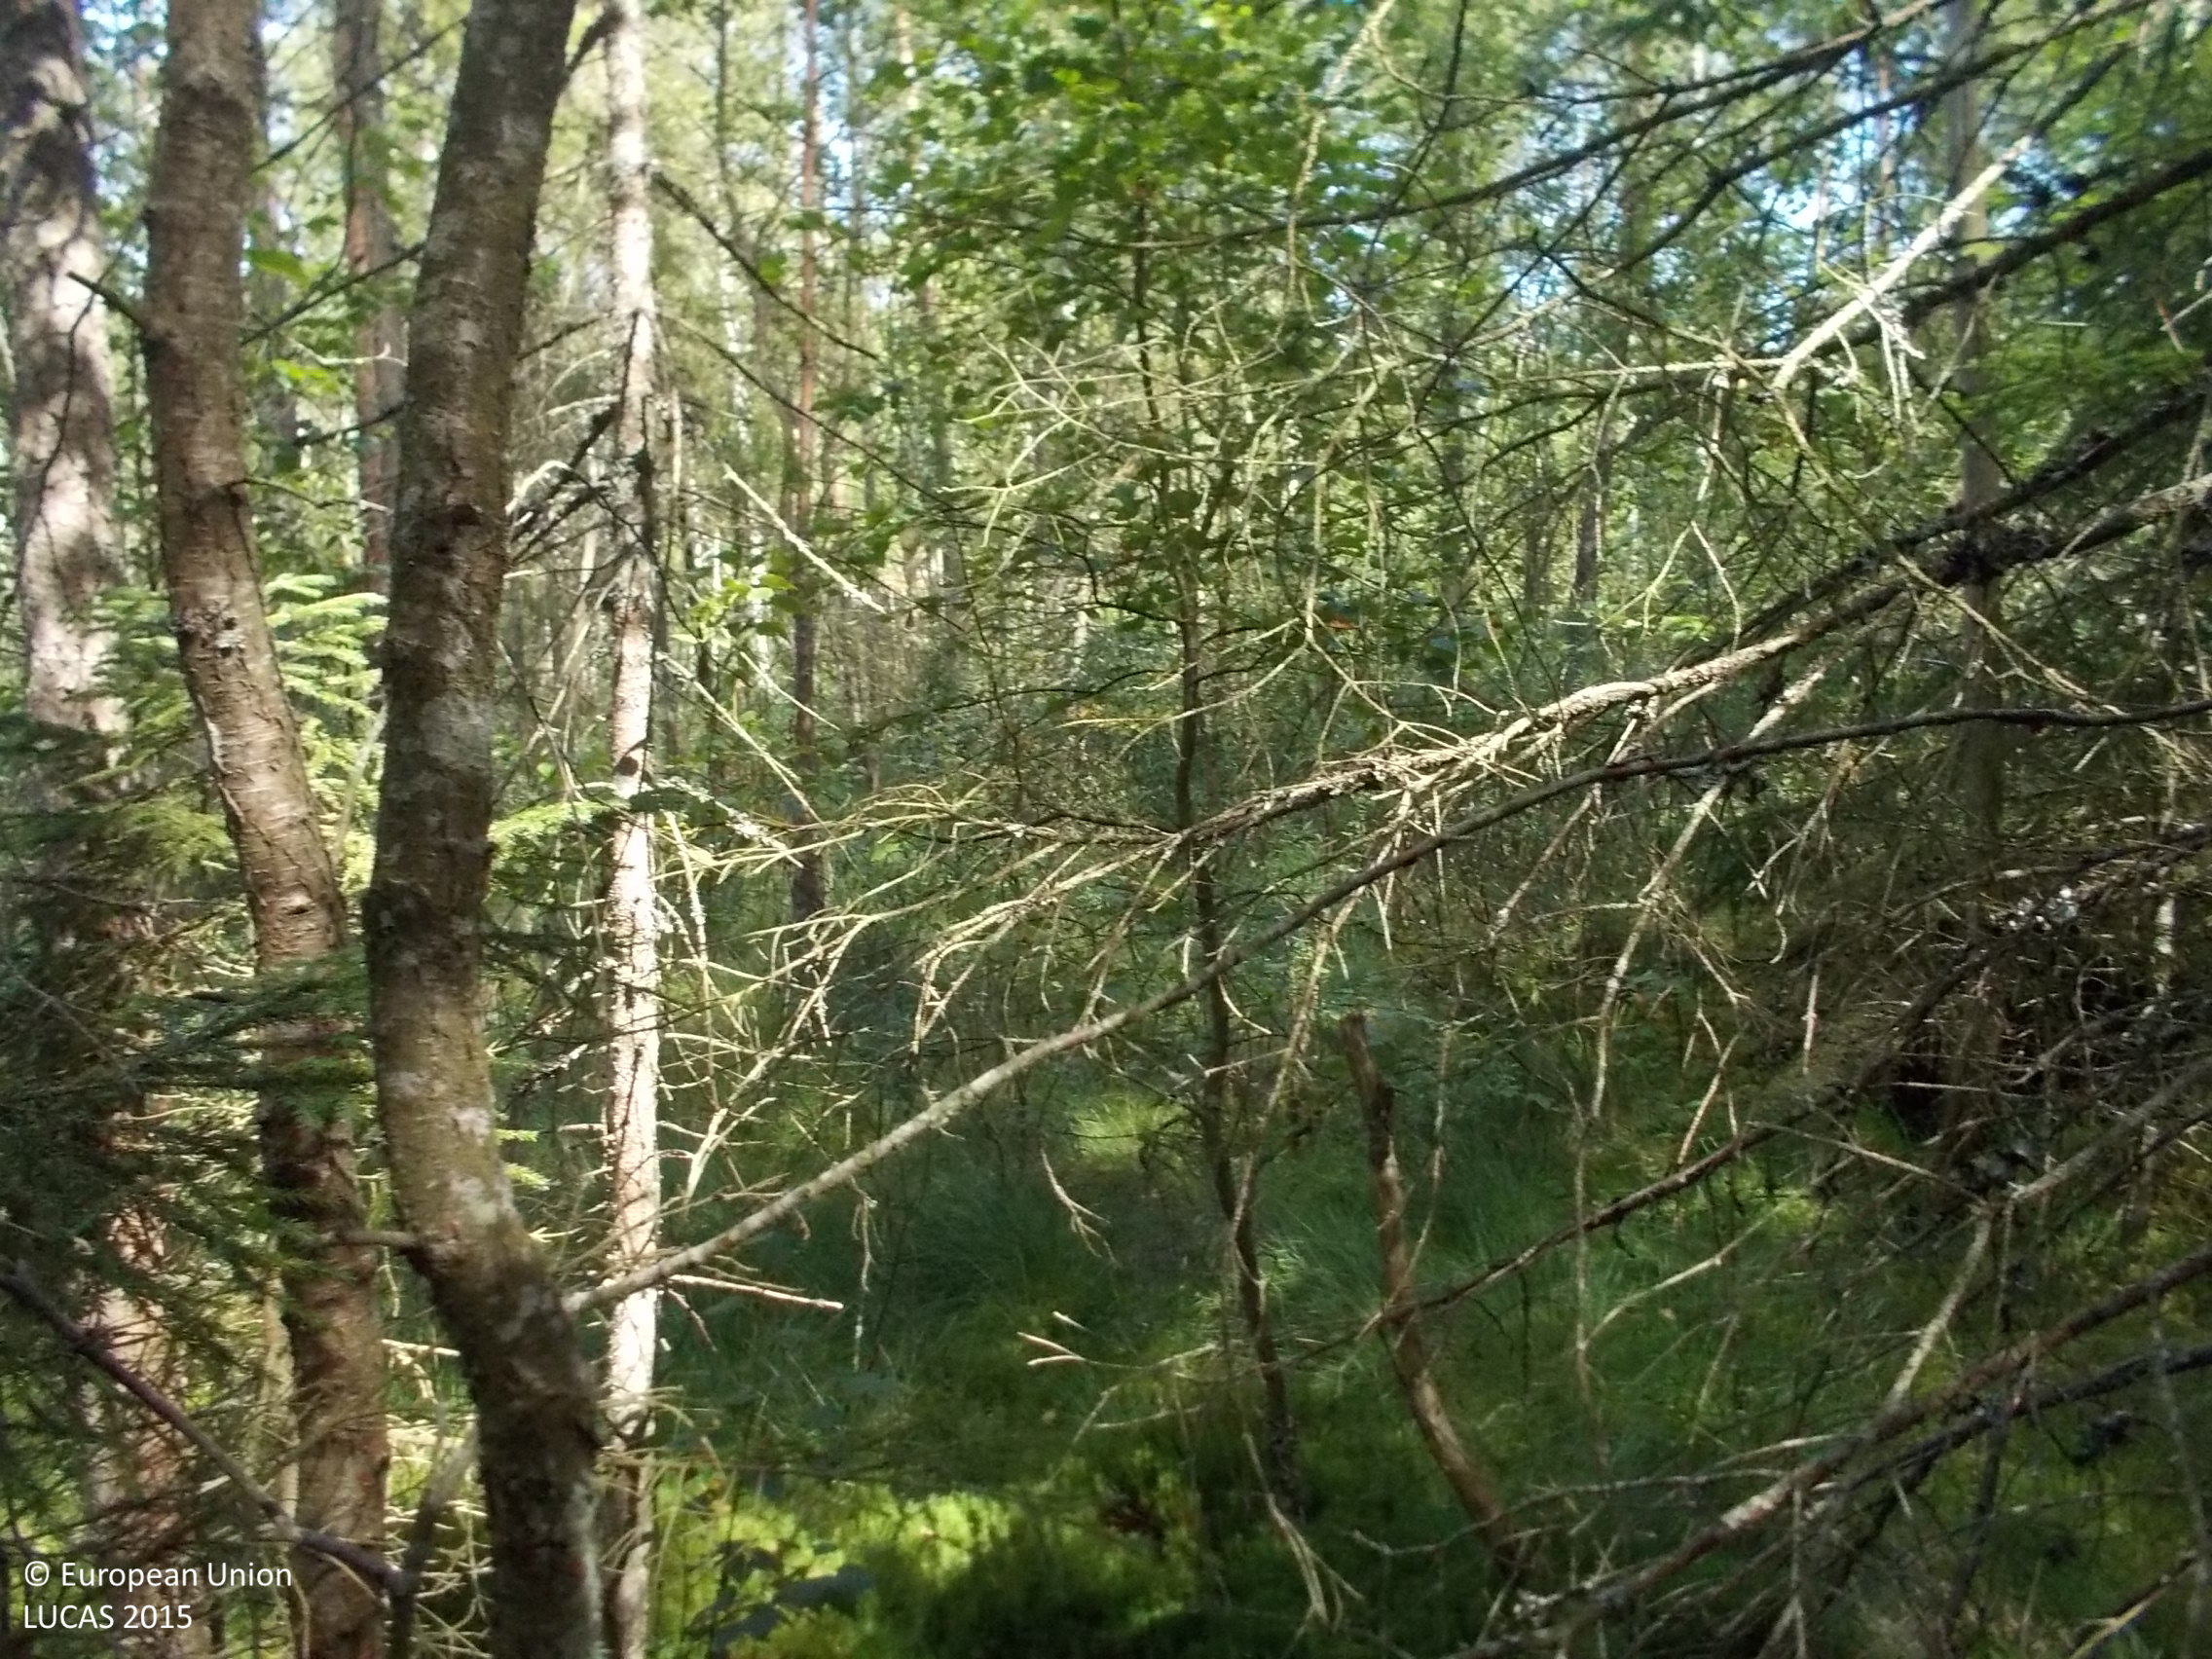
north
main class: Woodland
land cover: Other mixed woodland
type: boreal forest
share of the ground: > 75 %
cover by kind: coniferous forest trees 60 %, broadleaved forest trees 25 %, herbaceous plants 10 %, lichens and mosses 5 %
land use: Forestry
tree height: > 5 m
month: August
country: SE
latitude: 57.6228
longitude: 13.2270
